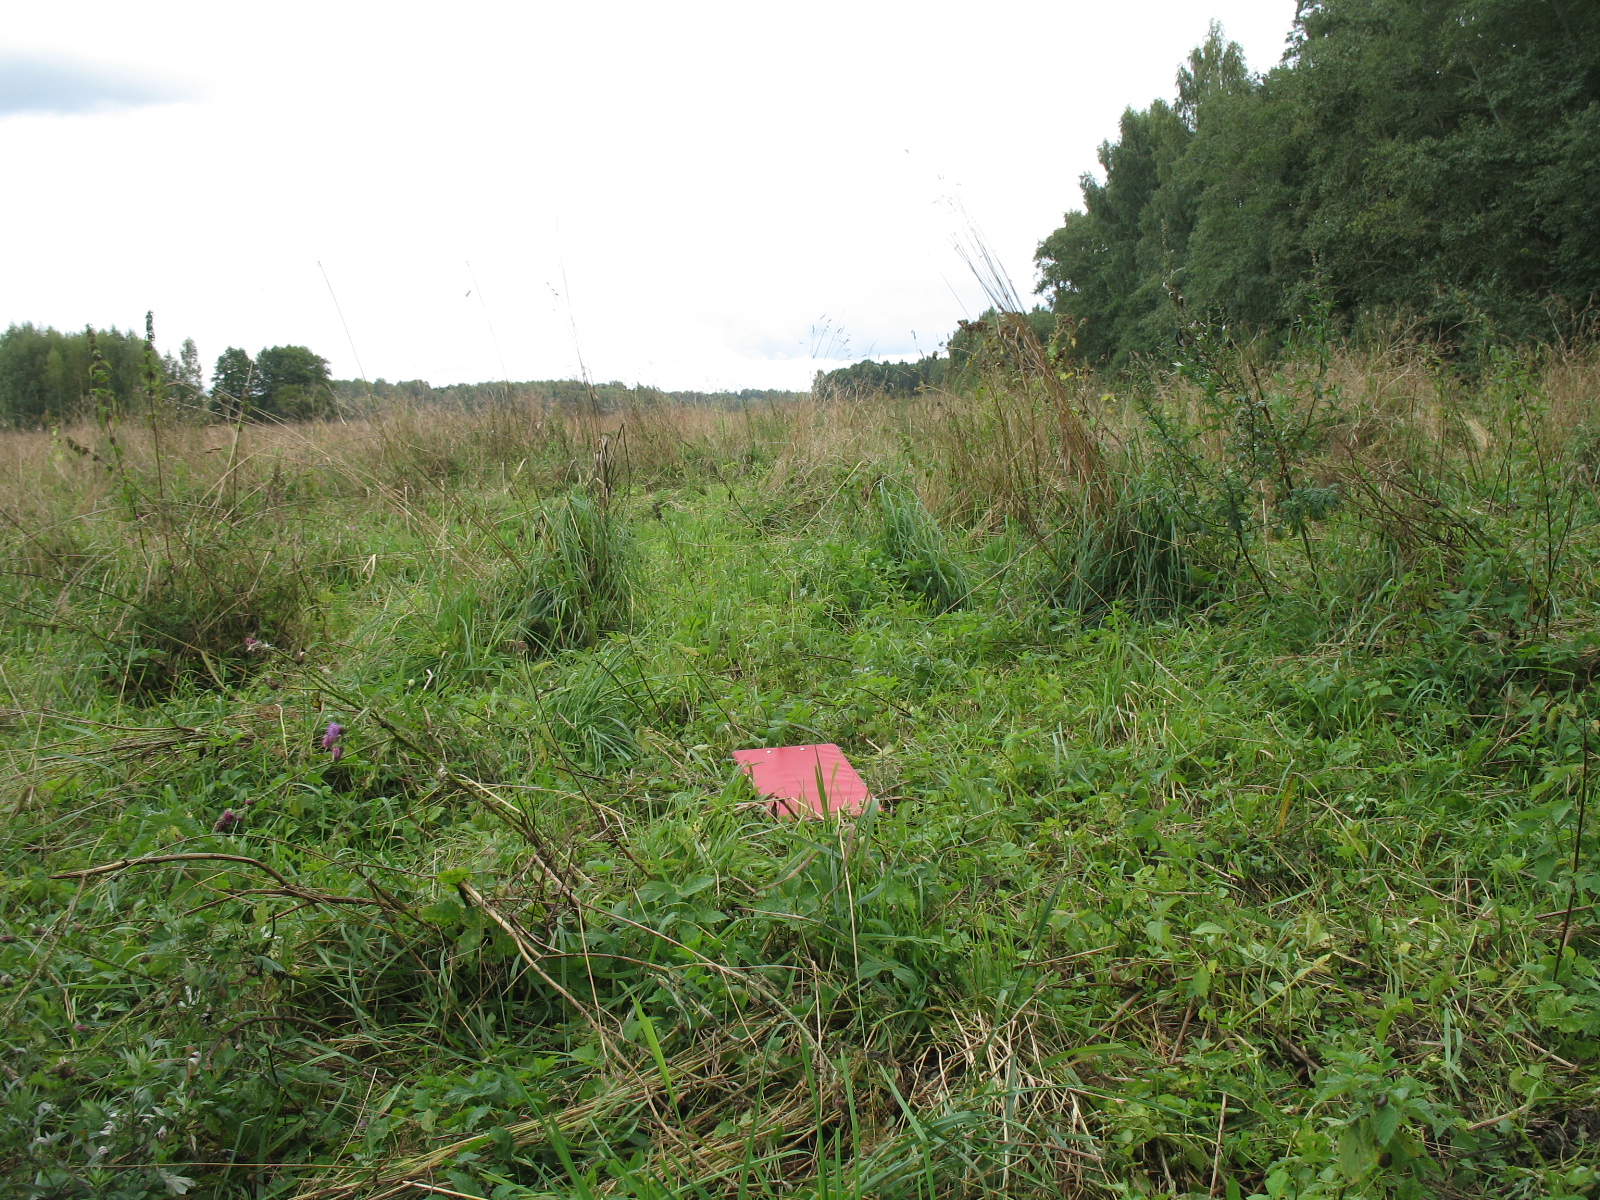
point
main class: Grassland
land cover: Grassland without tree/shrub cover
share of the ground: > 75 %
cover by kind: herbaceous plants 100 %
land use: Agriculture (excluding fallow land and kitchen gardens)
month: September
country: LV
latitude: 56.1182
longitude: 25.9443
